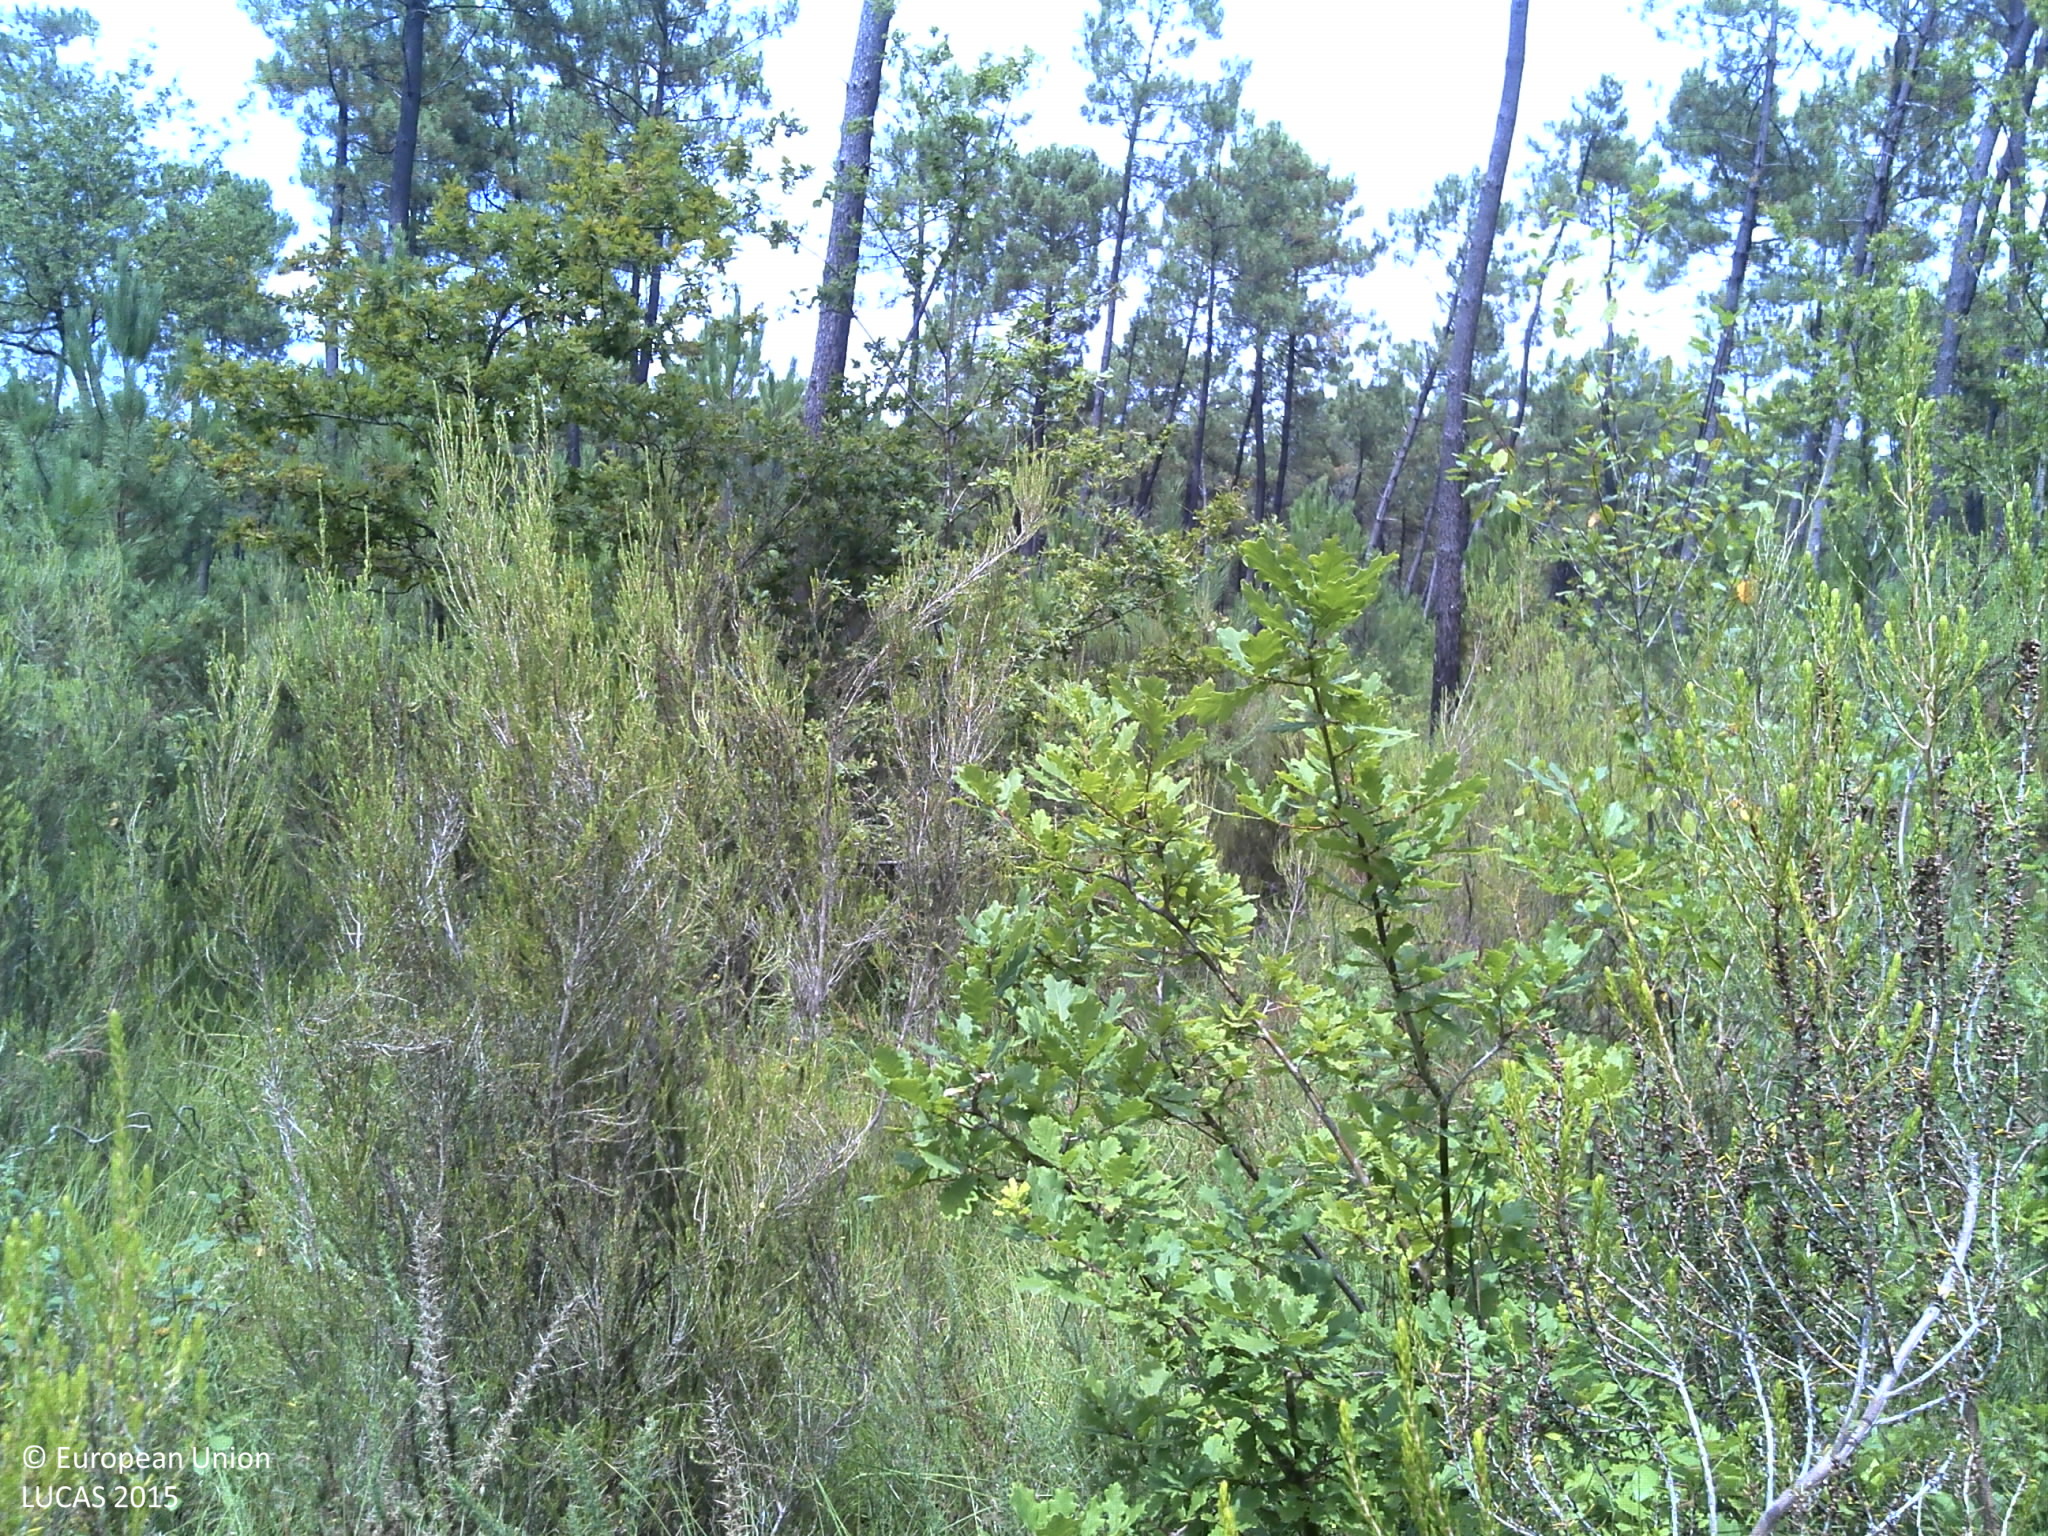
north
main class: Woodland
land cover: Pine dominated coniferous woodland
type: coniferous forest of the mediterranean region
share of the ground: > 75 %
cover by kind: coniferous forest trees 60 %, shrubs 25 %, broadleaved forest trees 10 %, herbaceous plants 5 %
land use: Forestry
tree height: < 5 m
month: August
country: FR
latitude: 44.8584
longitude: -0.9688
